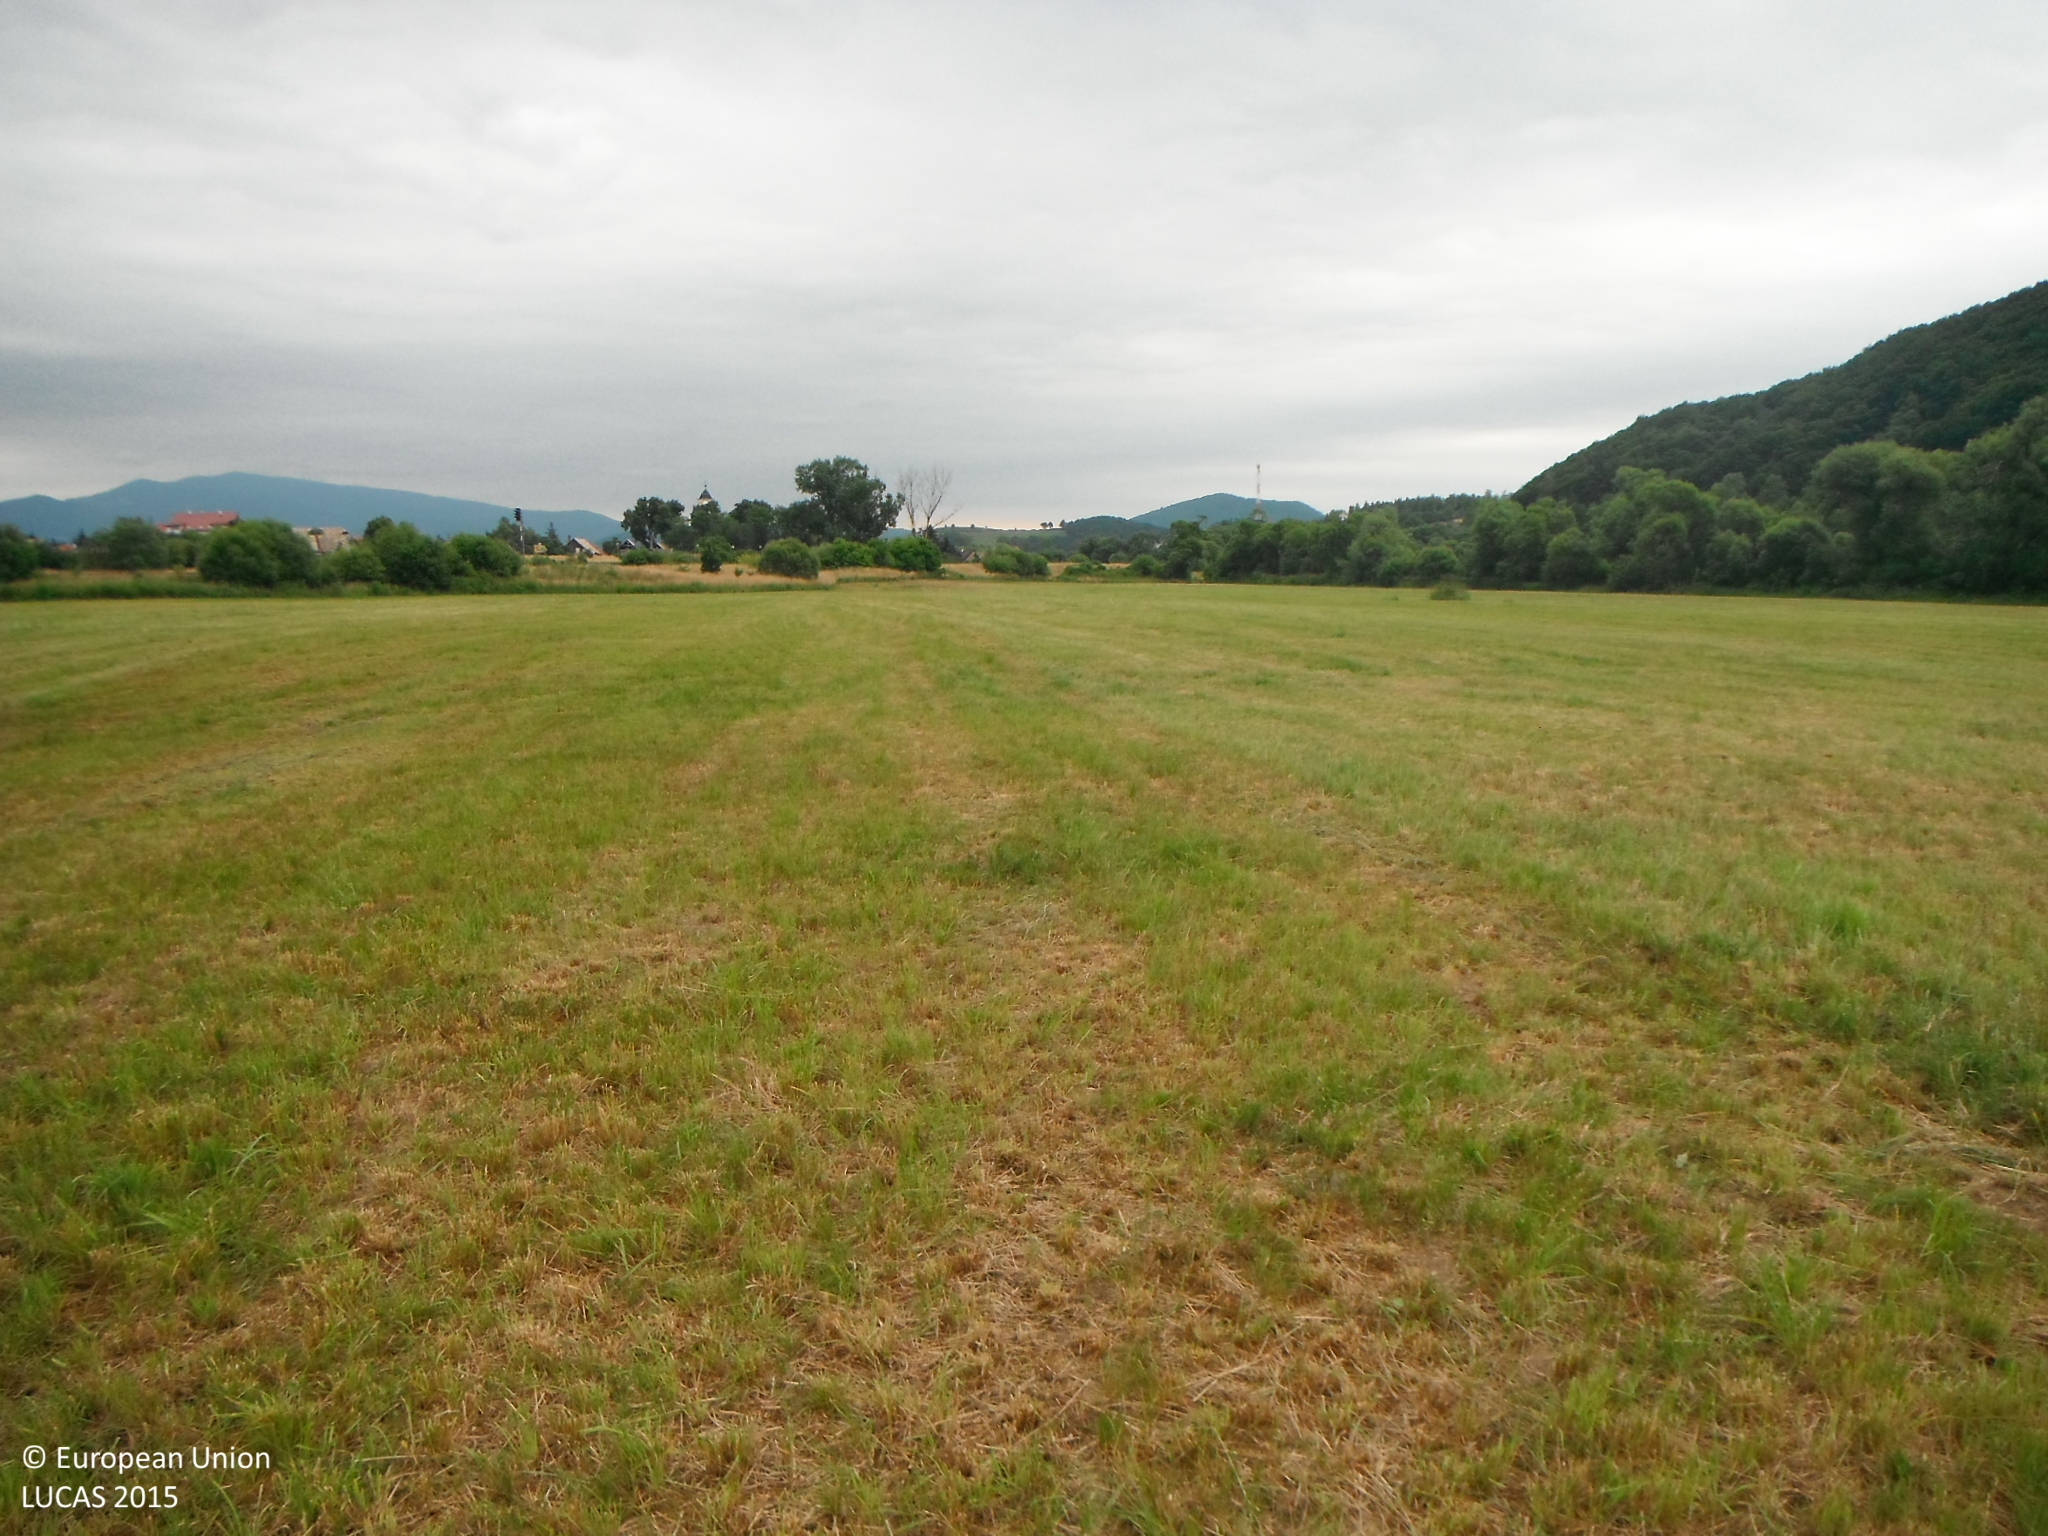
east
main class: Grassland
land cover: Grassland without tree/shrub cover
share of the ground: > 75 %
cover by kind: herbaceous plants 100 %
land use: Agriculture (excluding fallow land and kitchen gardens)
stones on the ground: < 10 %
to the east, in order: Grassland without tree/shrub cover
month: June
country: SK
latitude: 48.5583
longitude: 19.2498
